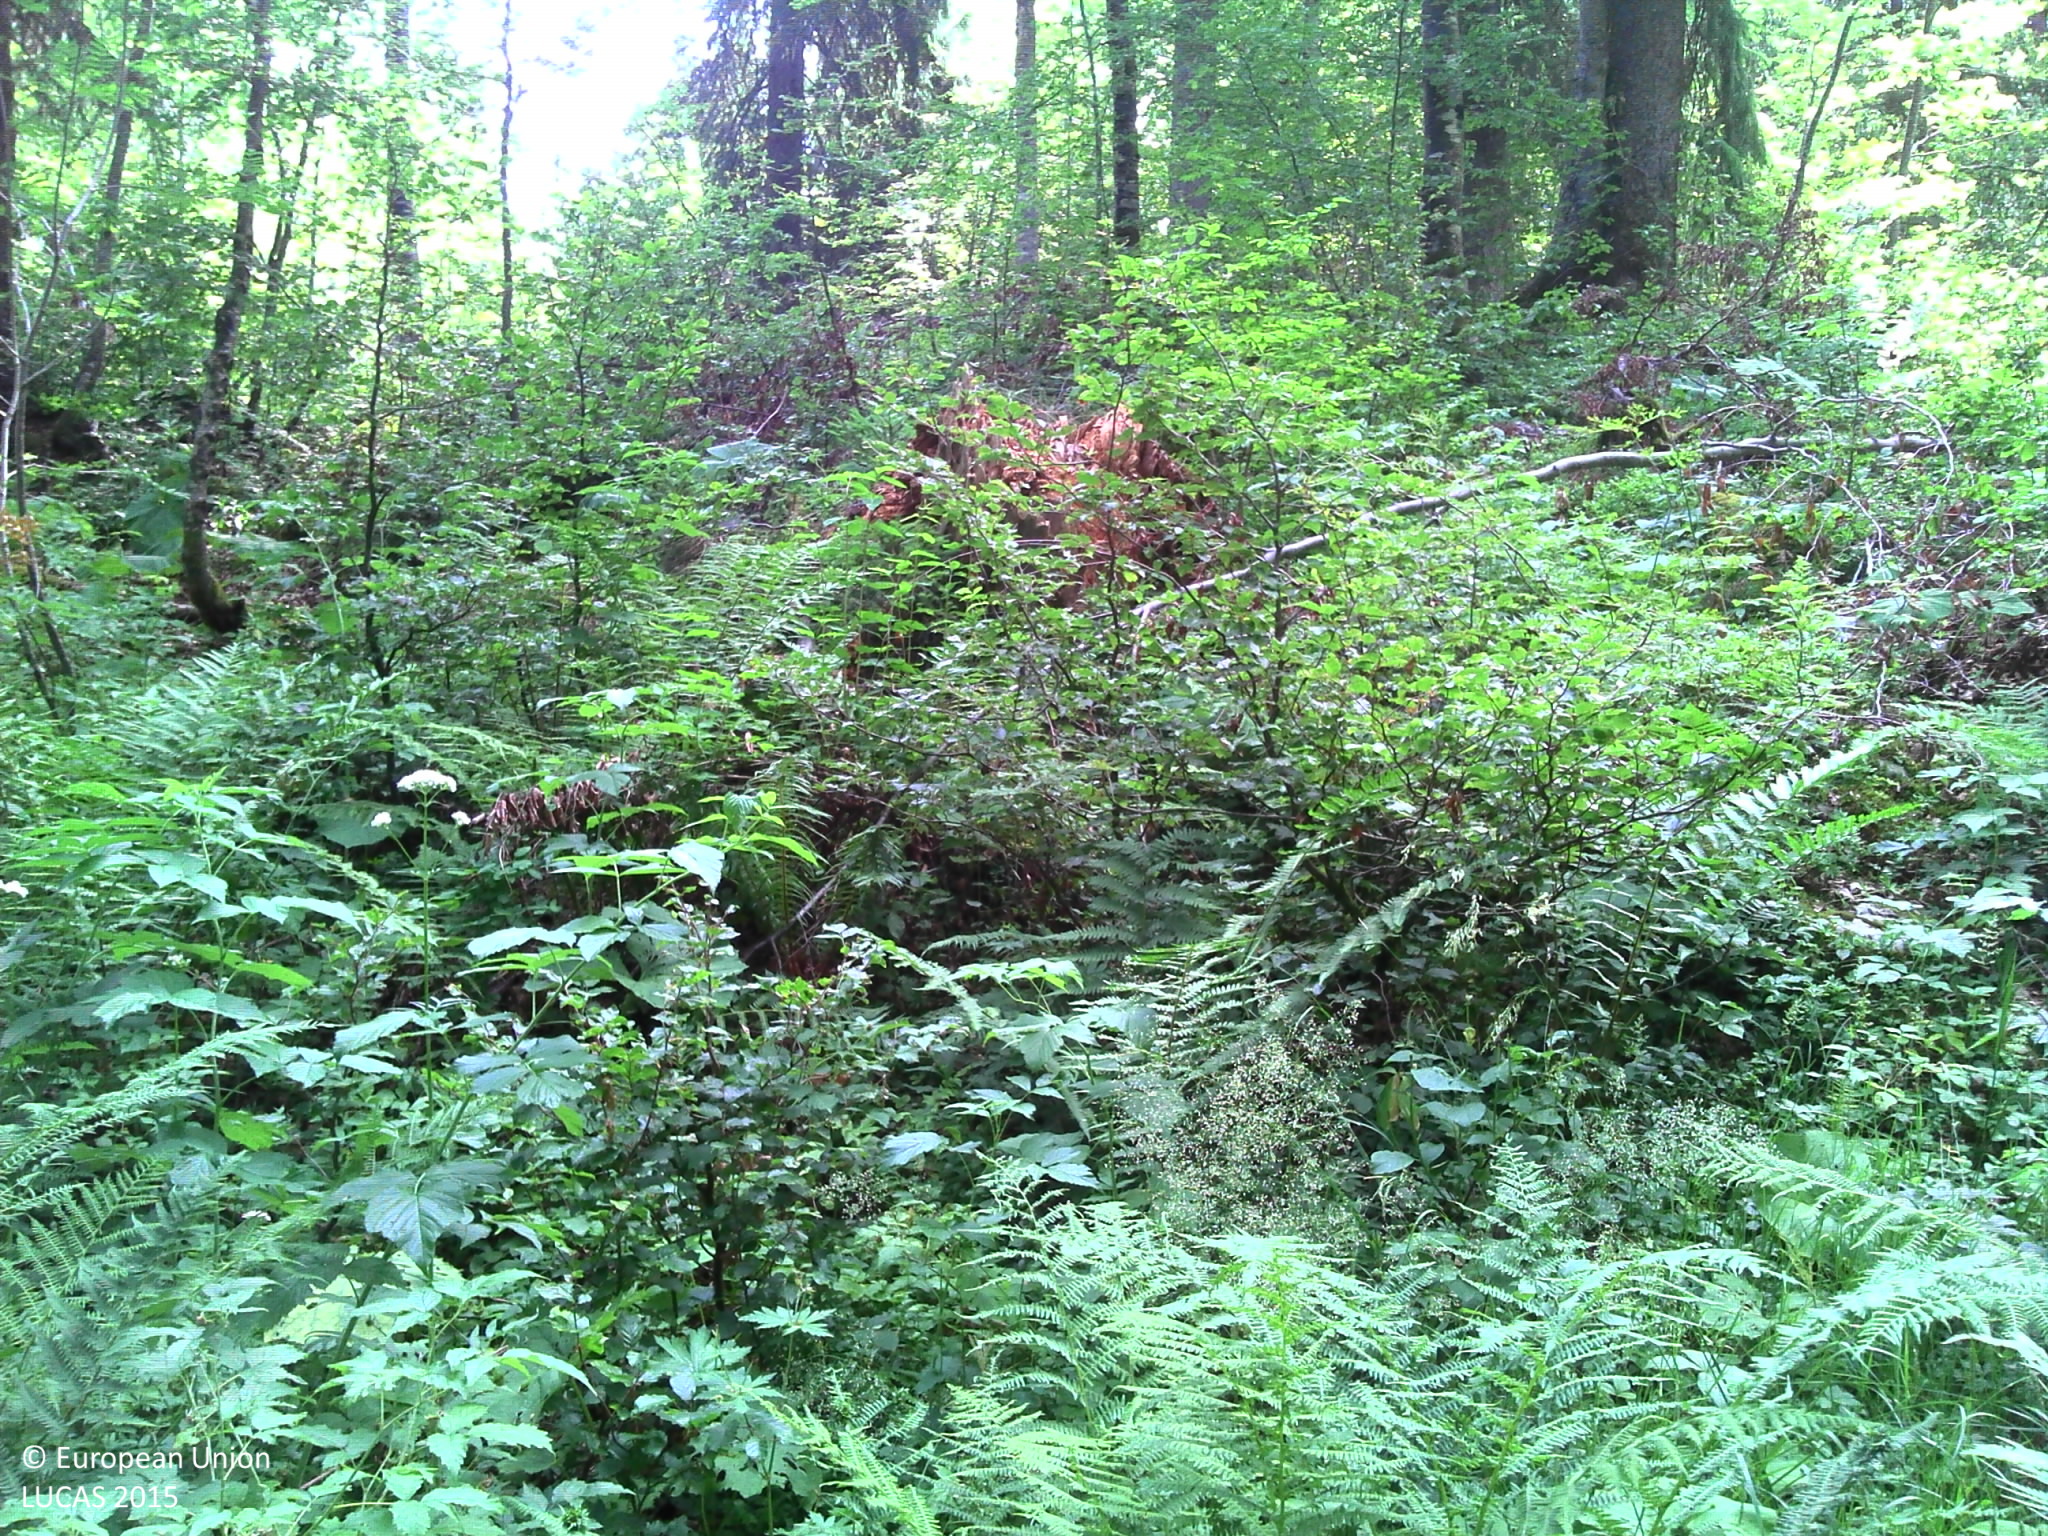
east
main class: Woodland
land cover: Spruce dominated mixed woodland
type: mountainous beech forest
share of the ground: 50 - 75 %
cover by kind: herbaceous plants 35 %, consolidated bare surface 20 %, coniferous forest trees 15 %, broadleaved forest trees 15 %, lichens and mosses 10 %, shrubs 5 %
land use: Forestry
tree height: > 5 m
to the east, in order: Spruce dominated mixed woodland; Dry stone walls; Spruce dominated mixed woodland; Tracks; Spontaneously vegetated surfaces; Spruce dominated mixed woodland
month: July
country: FR
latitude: 46.5138
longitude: 6.0798
